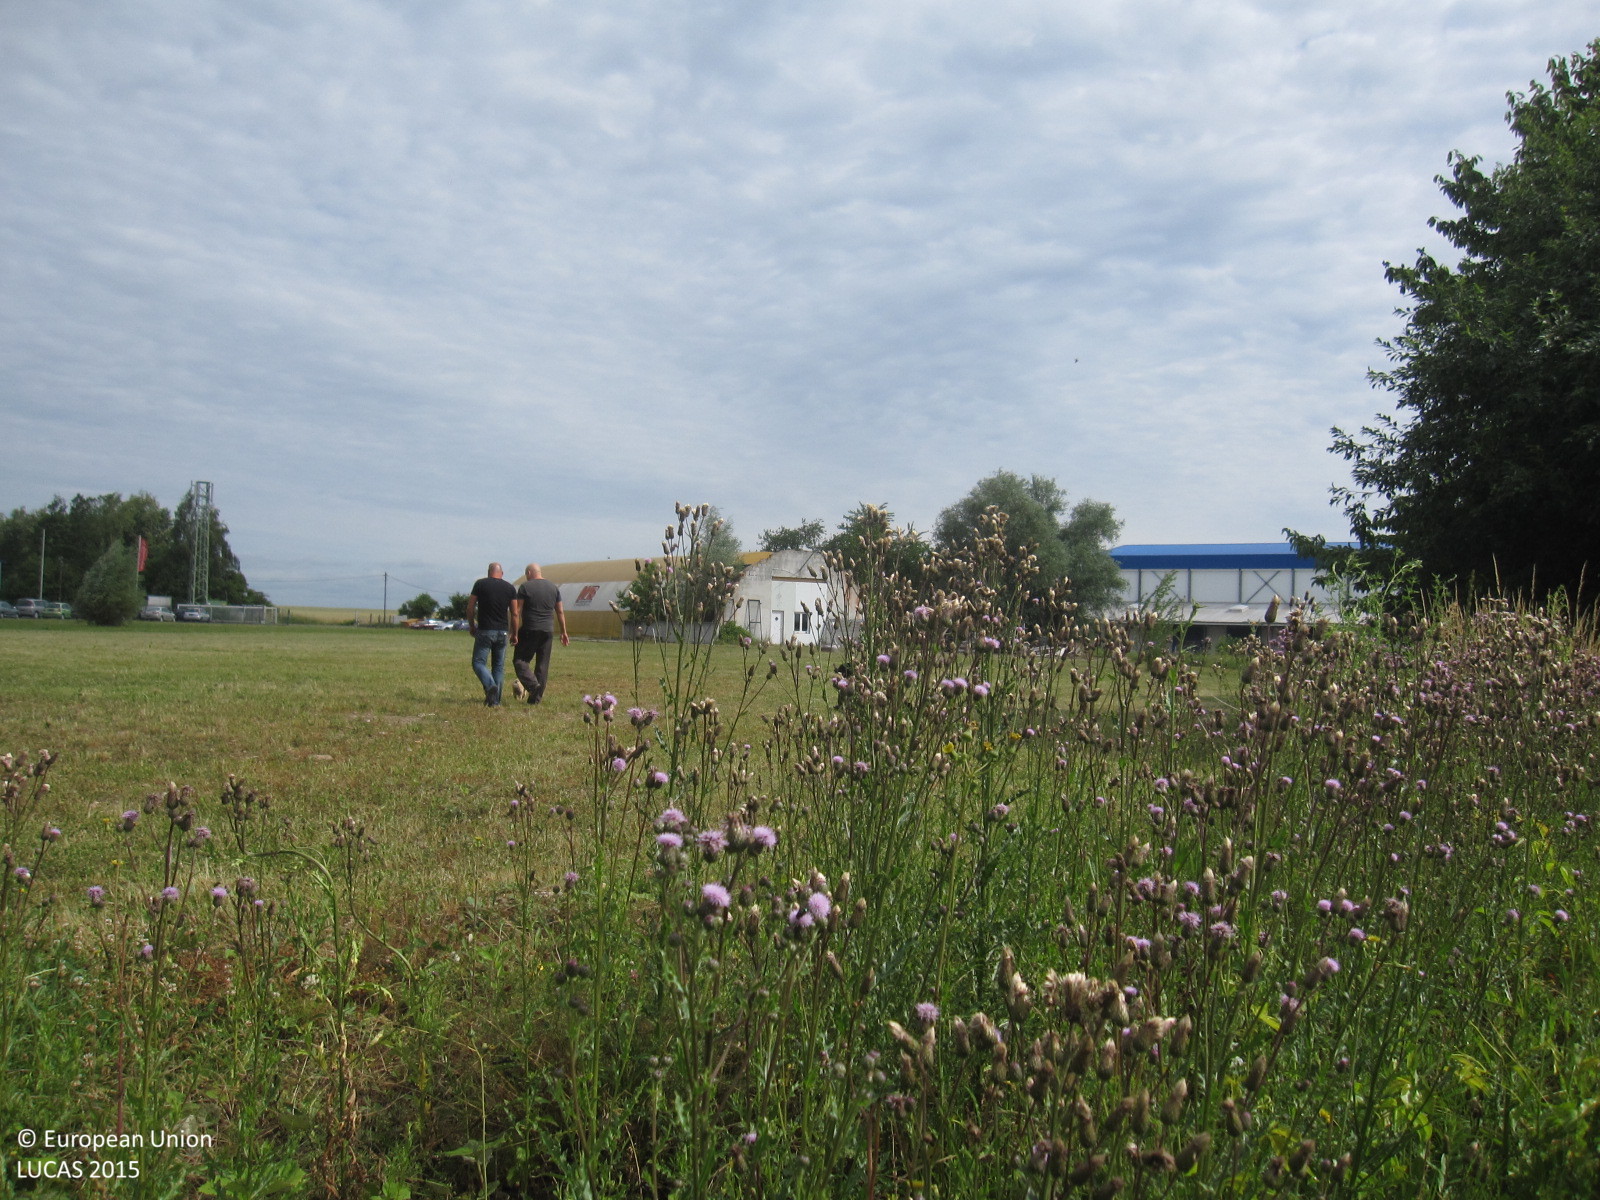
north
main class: Grassland
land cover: Spontaneously vegetated surfaces
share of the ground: > 75 %
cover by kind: herbaceous plants 90 %, consolidated bare surface 10 %
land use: Abandoned areas
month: July
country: DE
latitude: 50.8835
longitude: 12.1460
